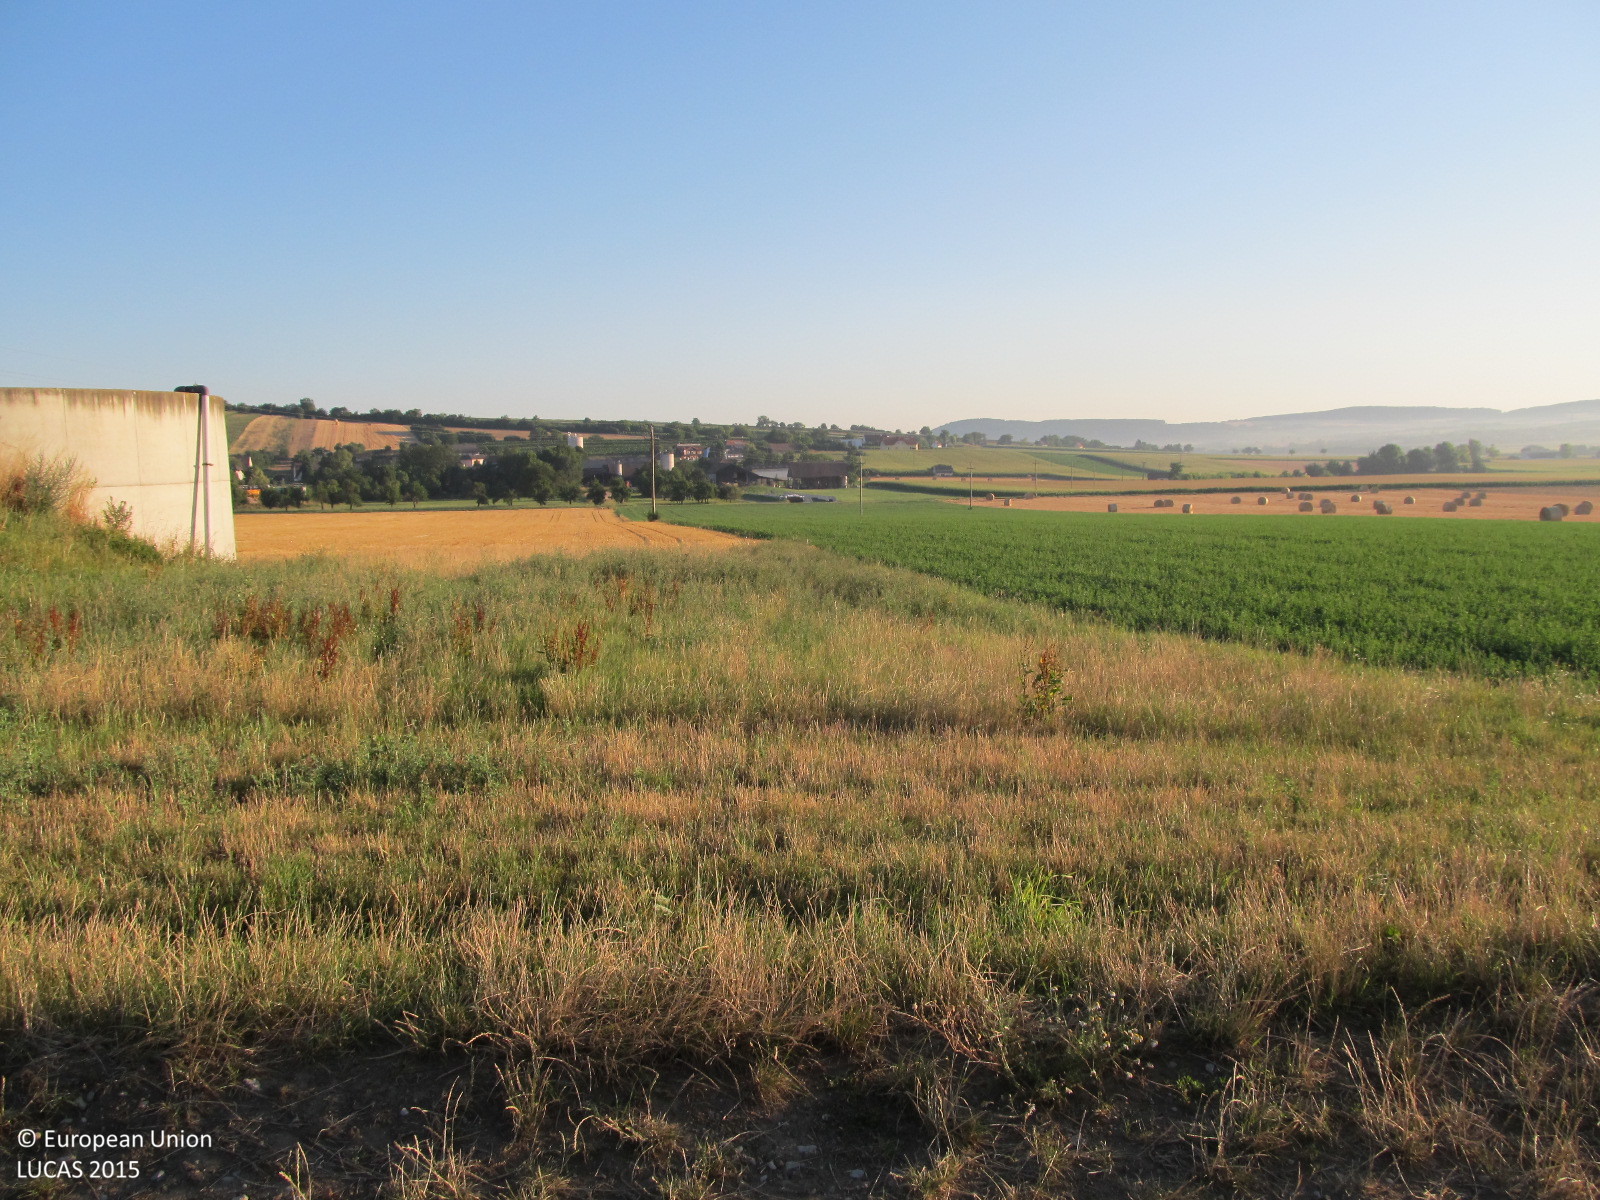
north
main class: Cropland
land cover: Maize
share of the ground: > 75 %
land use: Agriculture (excluding fallow land and kitchen gardens)
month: July
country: AT
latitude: 48.2785
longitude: 15.6219
